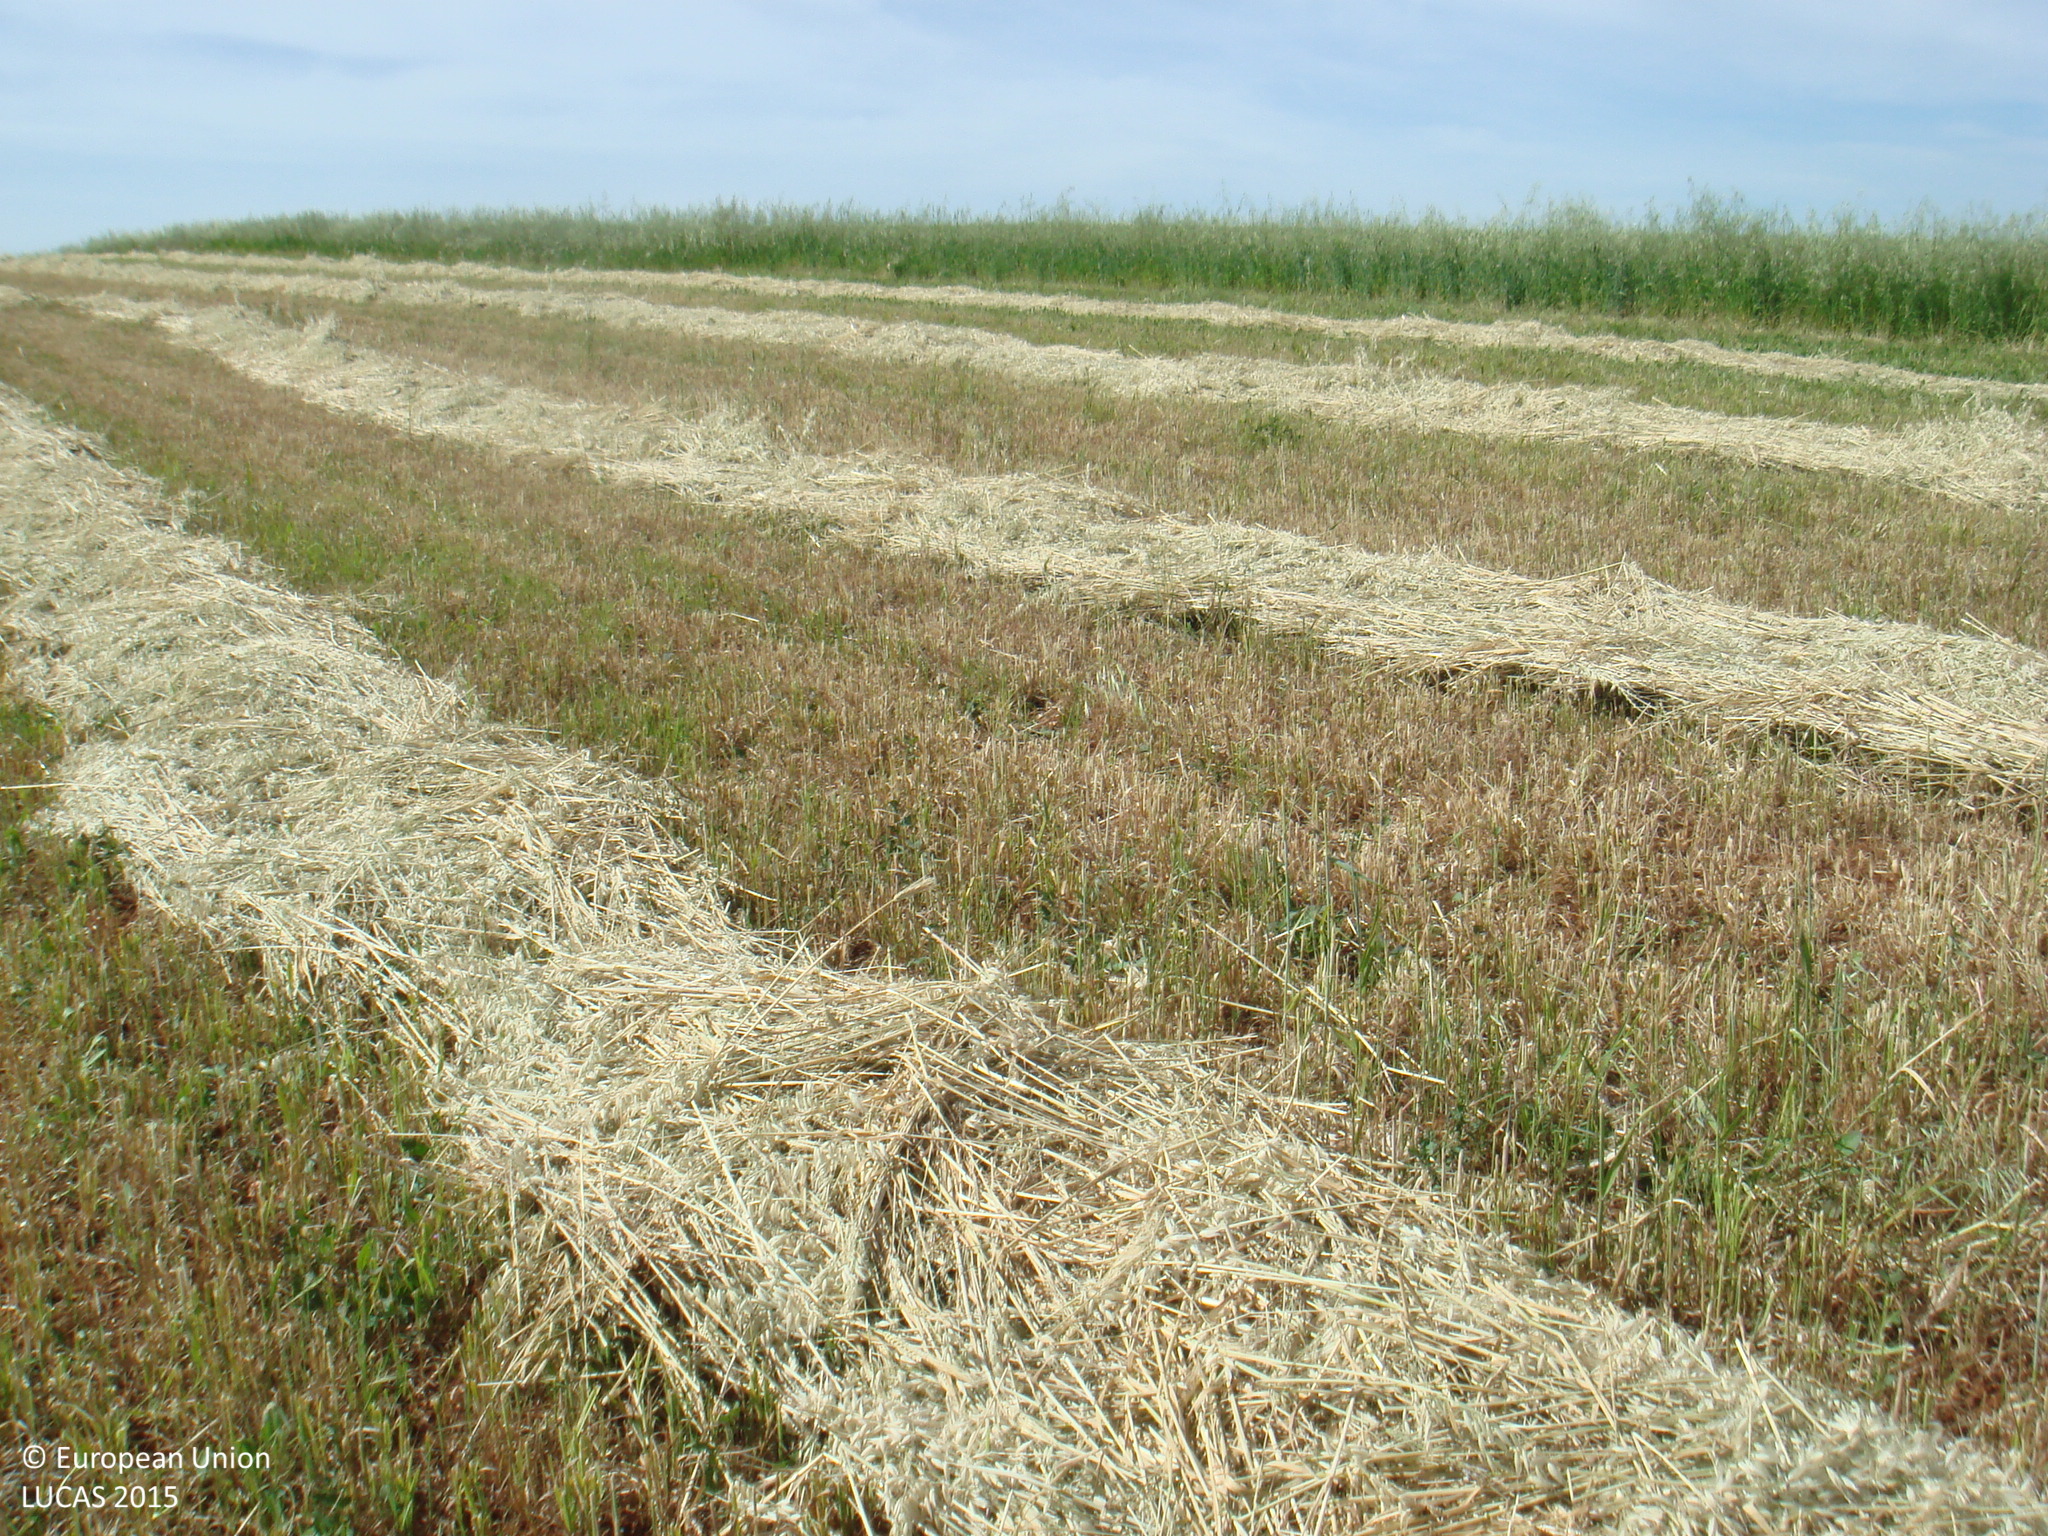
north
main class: Grassland
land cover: Grassland without tree/shrub cover
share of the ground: > 75 %
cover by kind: consolidated bare surface 80 %, herbaceous plants 20 %
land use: Agriculture (excluding fallow land and kitchen gardens)
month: April
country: ES
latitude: 38.4449
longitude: -5.1182
